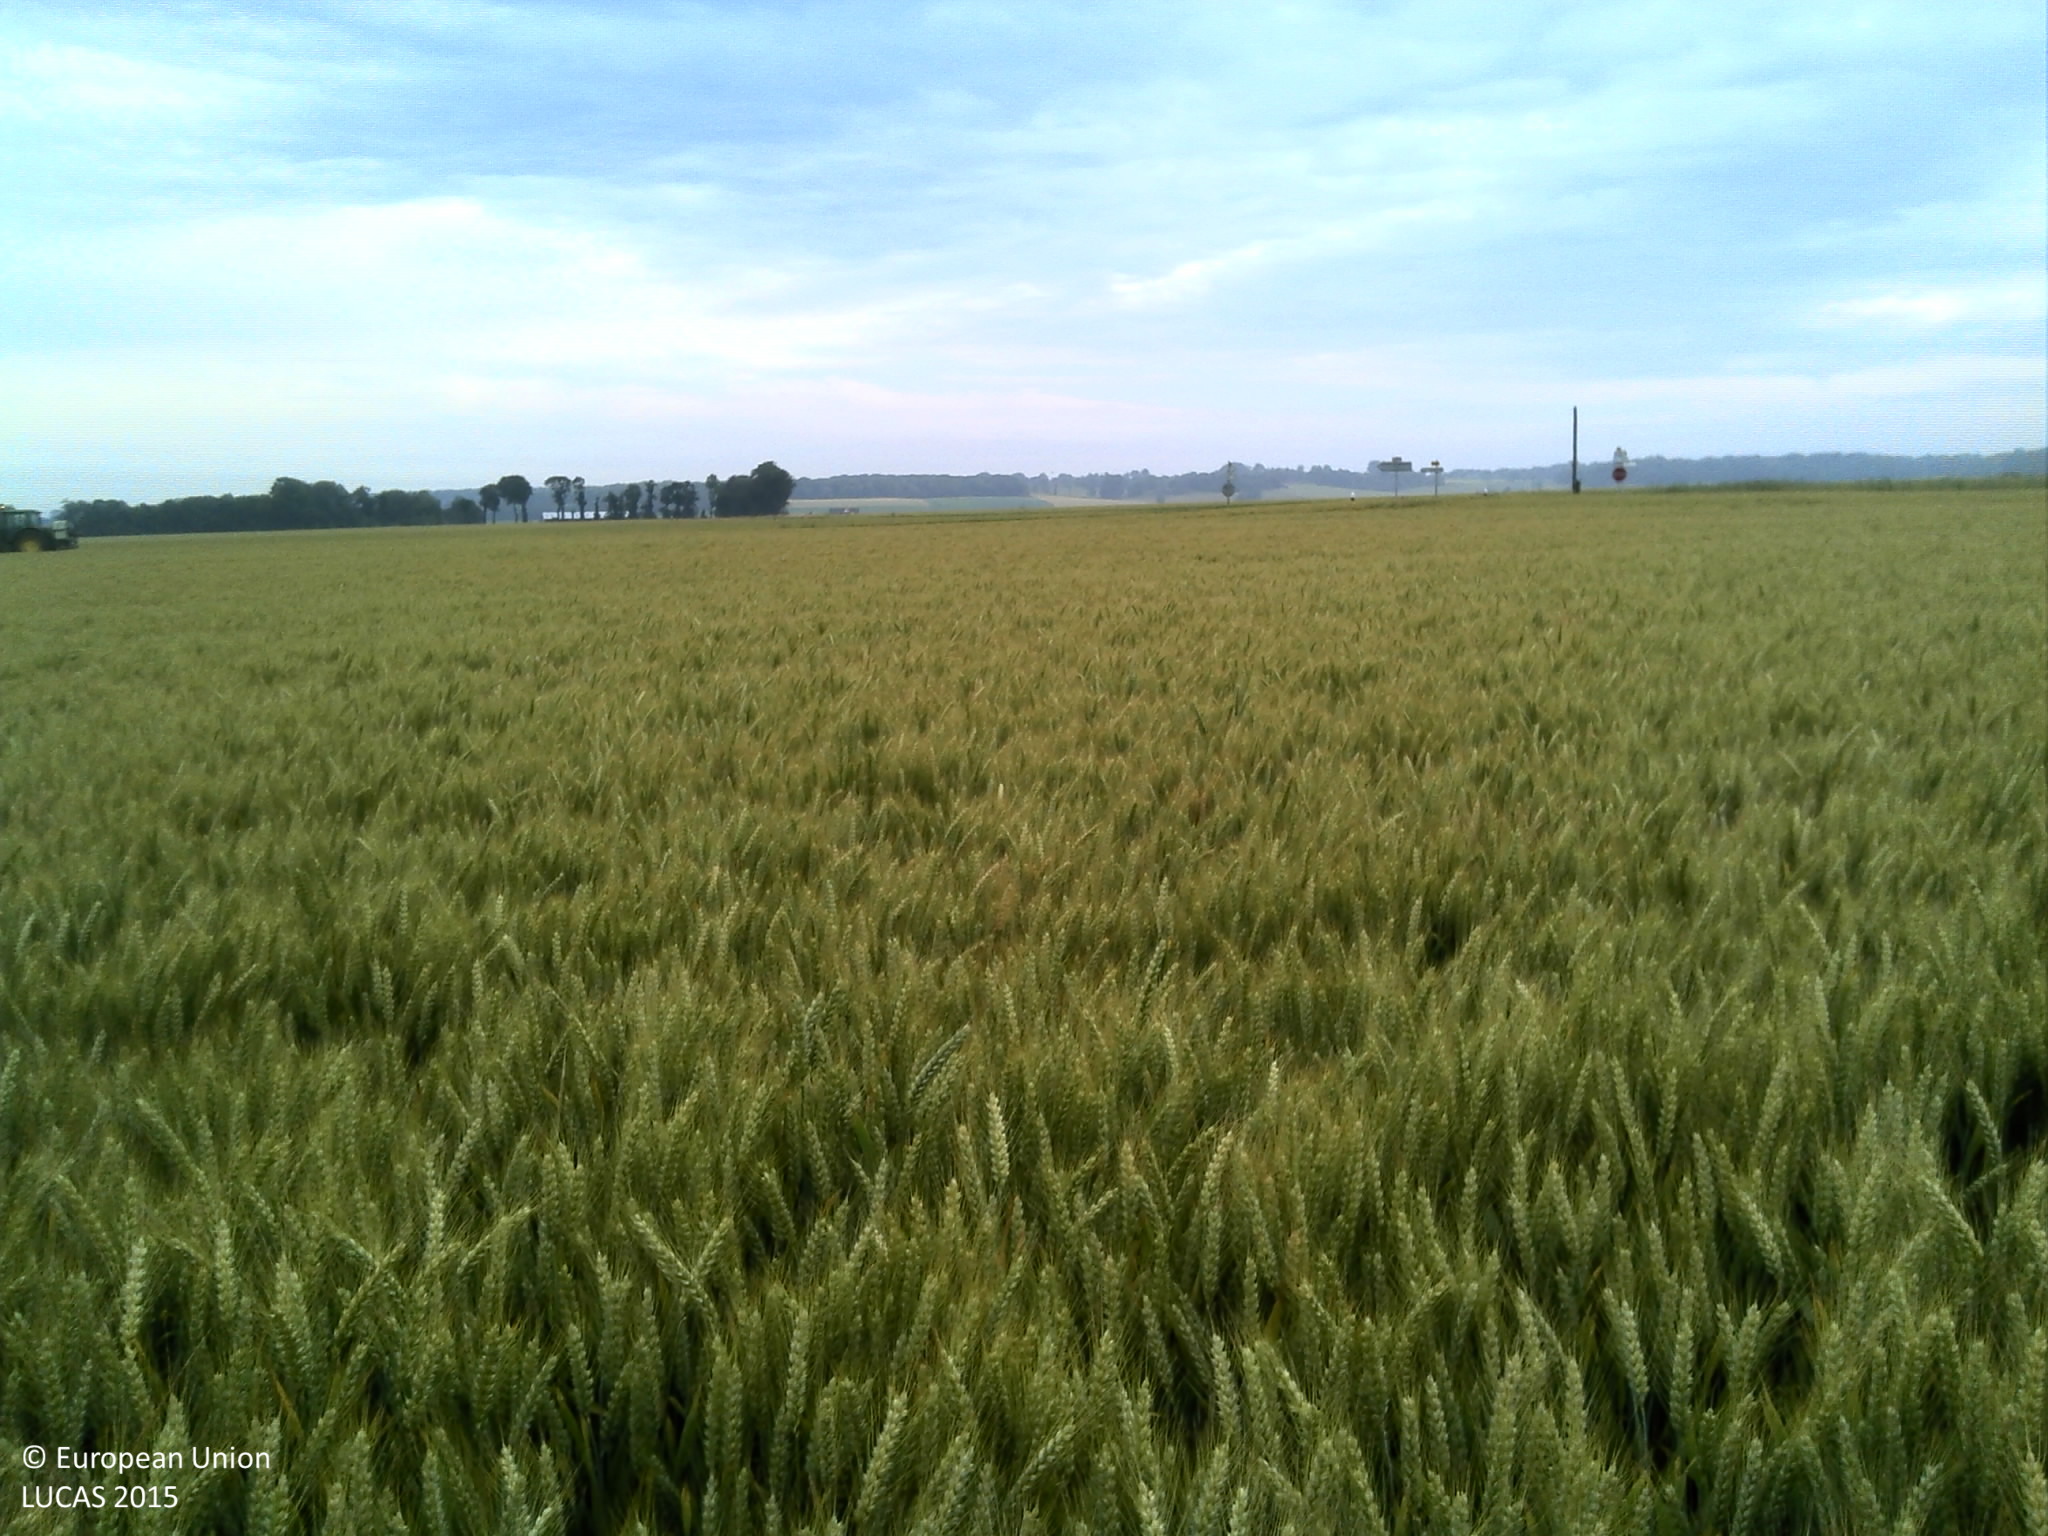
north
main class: Cropland
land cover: Durum wheat
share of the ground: > 75 %
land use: Agriculture (excluding fallow land and kitchen gardens)
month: July
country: FR
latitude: 49.8799
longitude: 0.9732
